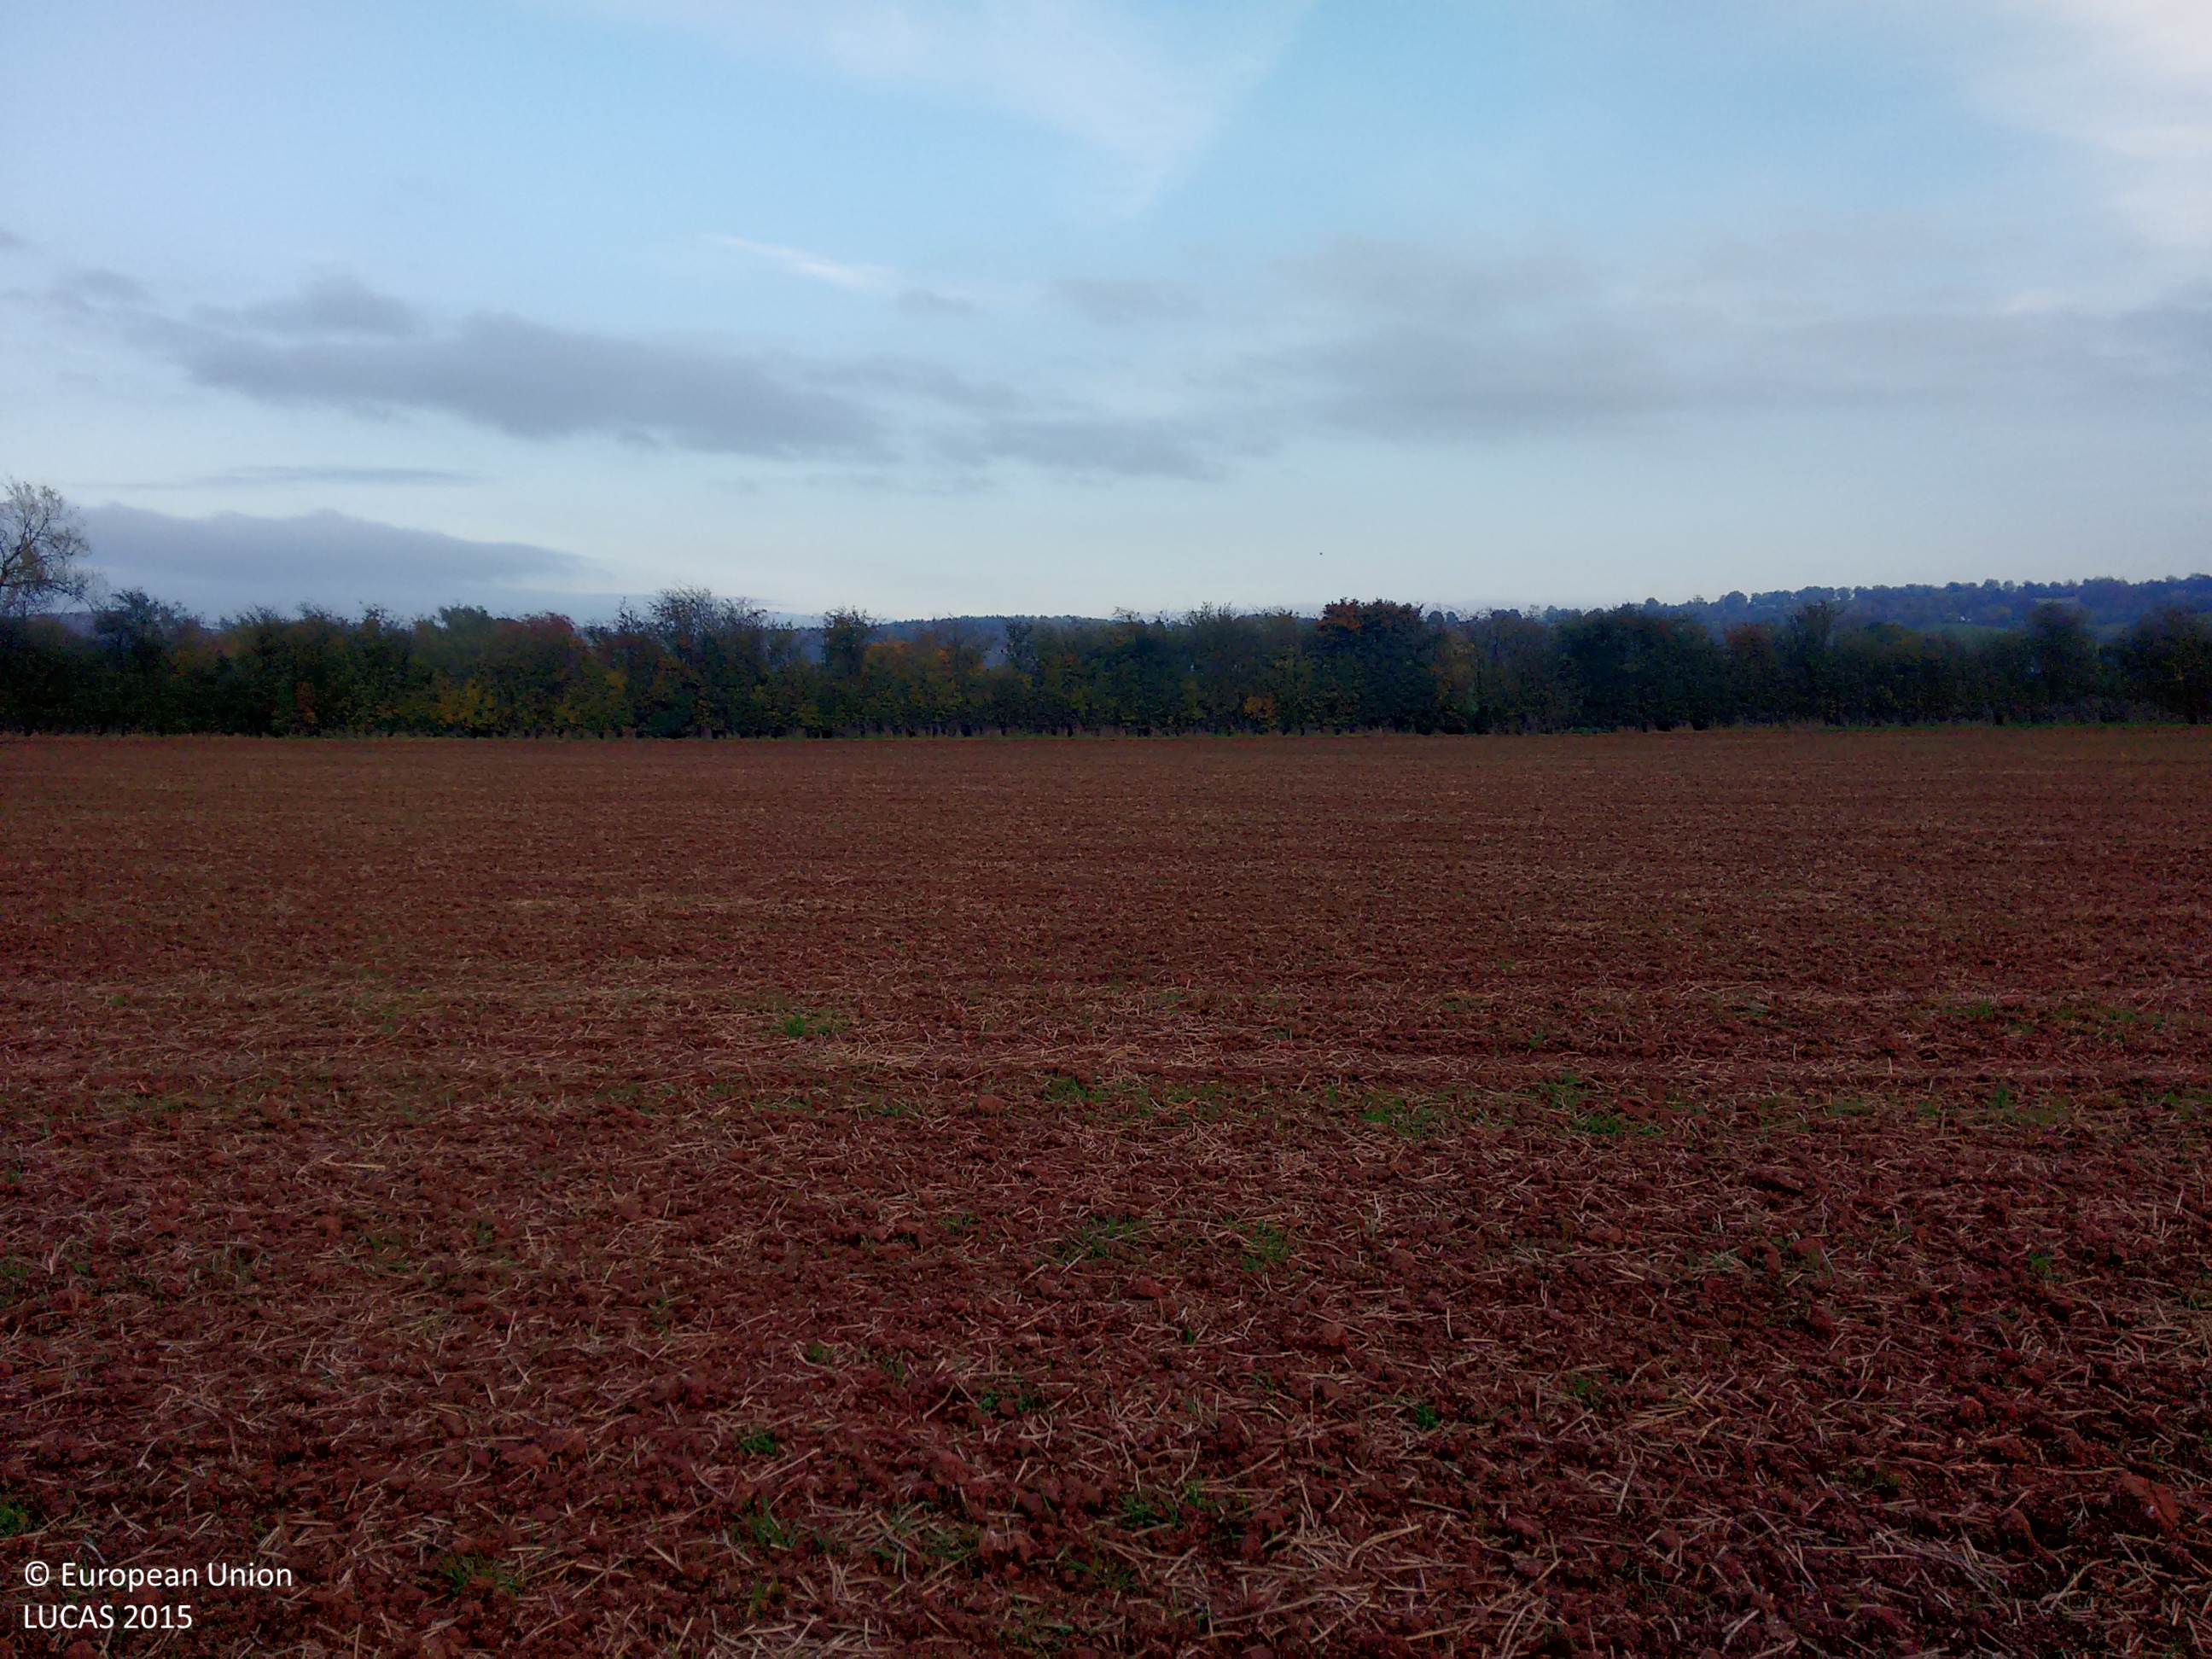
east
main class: Cropland
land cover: Oats
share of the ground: < 10 %
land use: Agriculture (excluding fallow land and kitchen gardens)
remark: Tilled/Sowed
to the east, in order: Oats; Managed hedges; Fences; Other bare soil
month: October
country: GB
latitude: 52.4347
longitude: -2.7347
